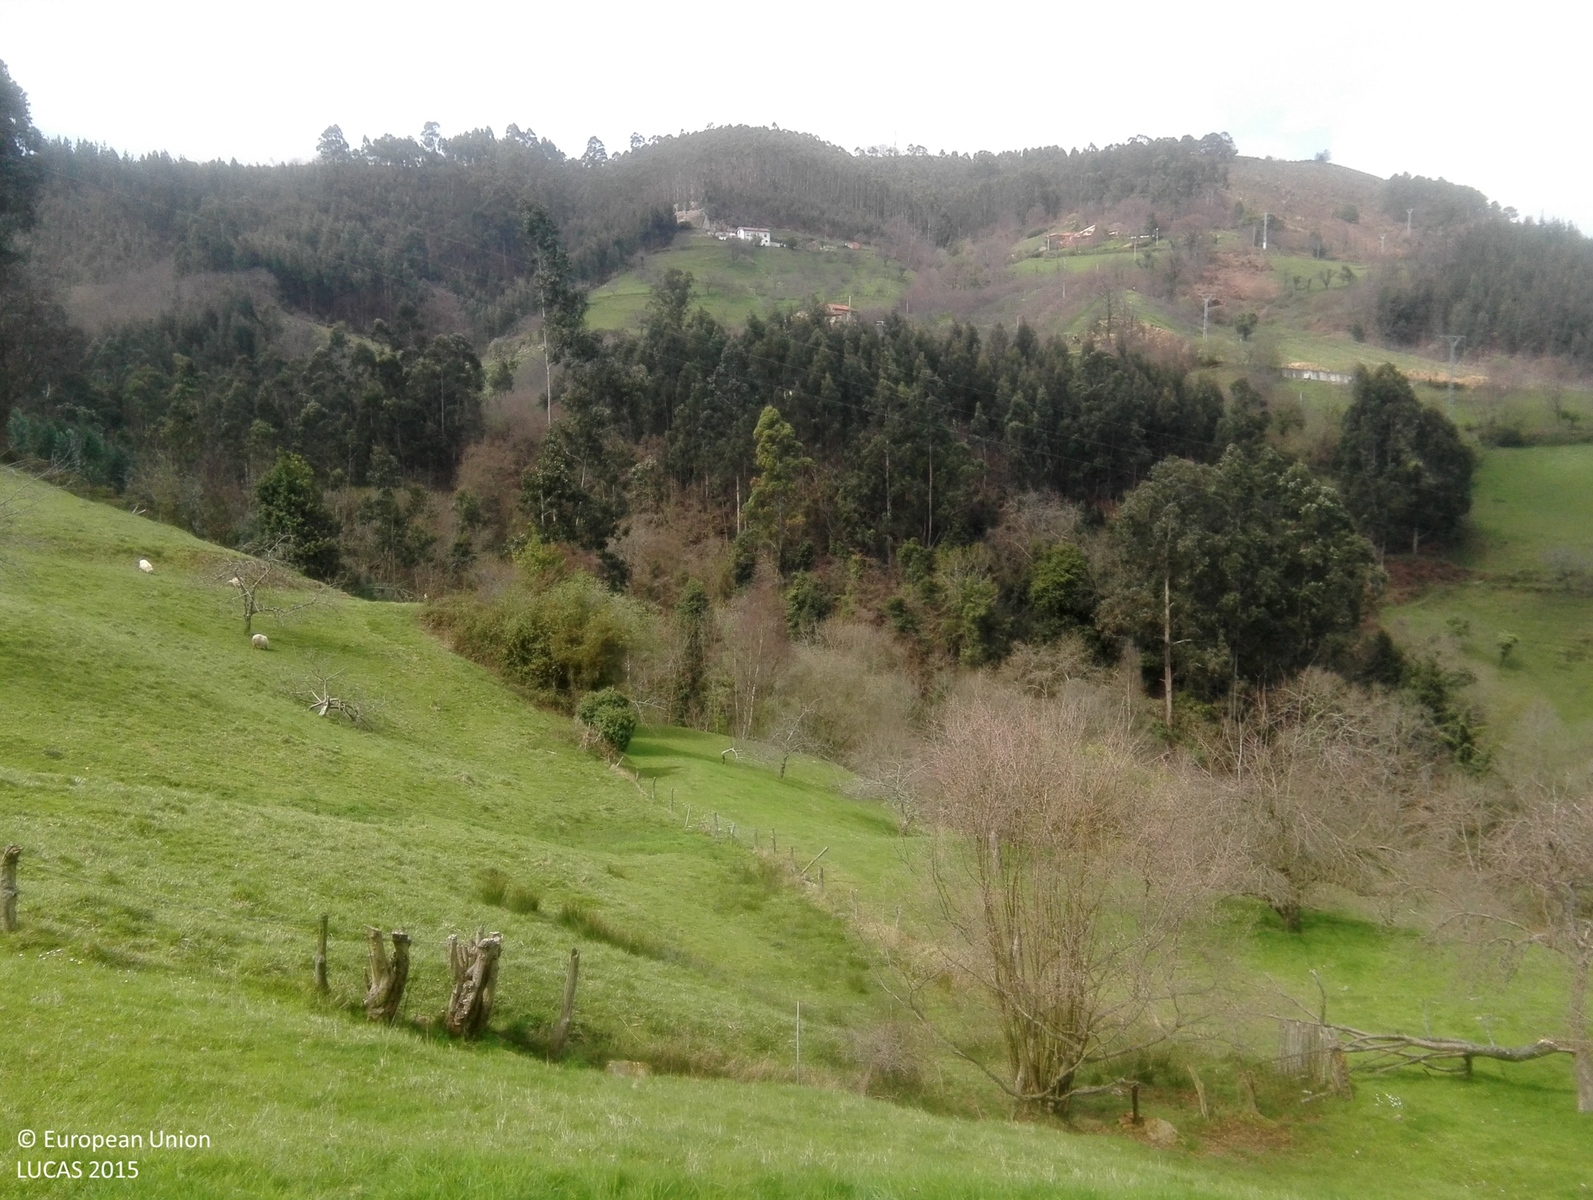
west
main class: Cropland
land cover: Apple fruit
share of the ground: 50 - 75 %
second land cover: Grassland without tree/shrub cover
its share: > 75 %
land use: Agriculture (excluding fallow land and kitchen gardens)
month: April
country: ES
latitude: 43.4667
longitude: -5.6465
